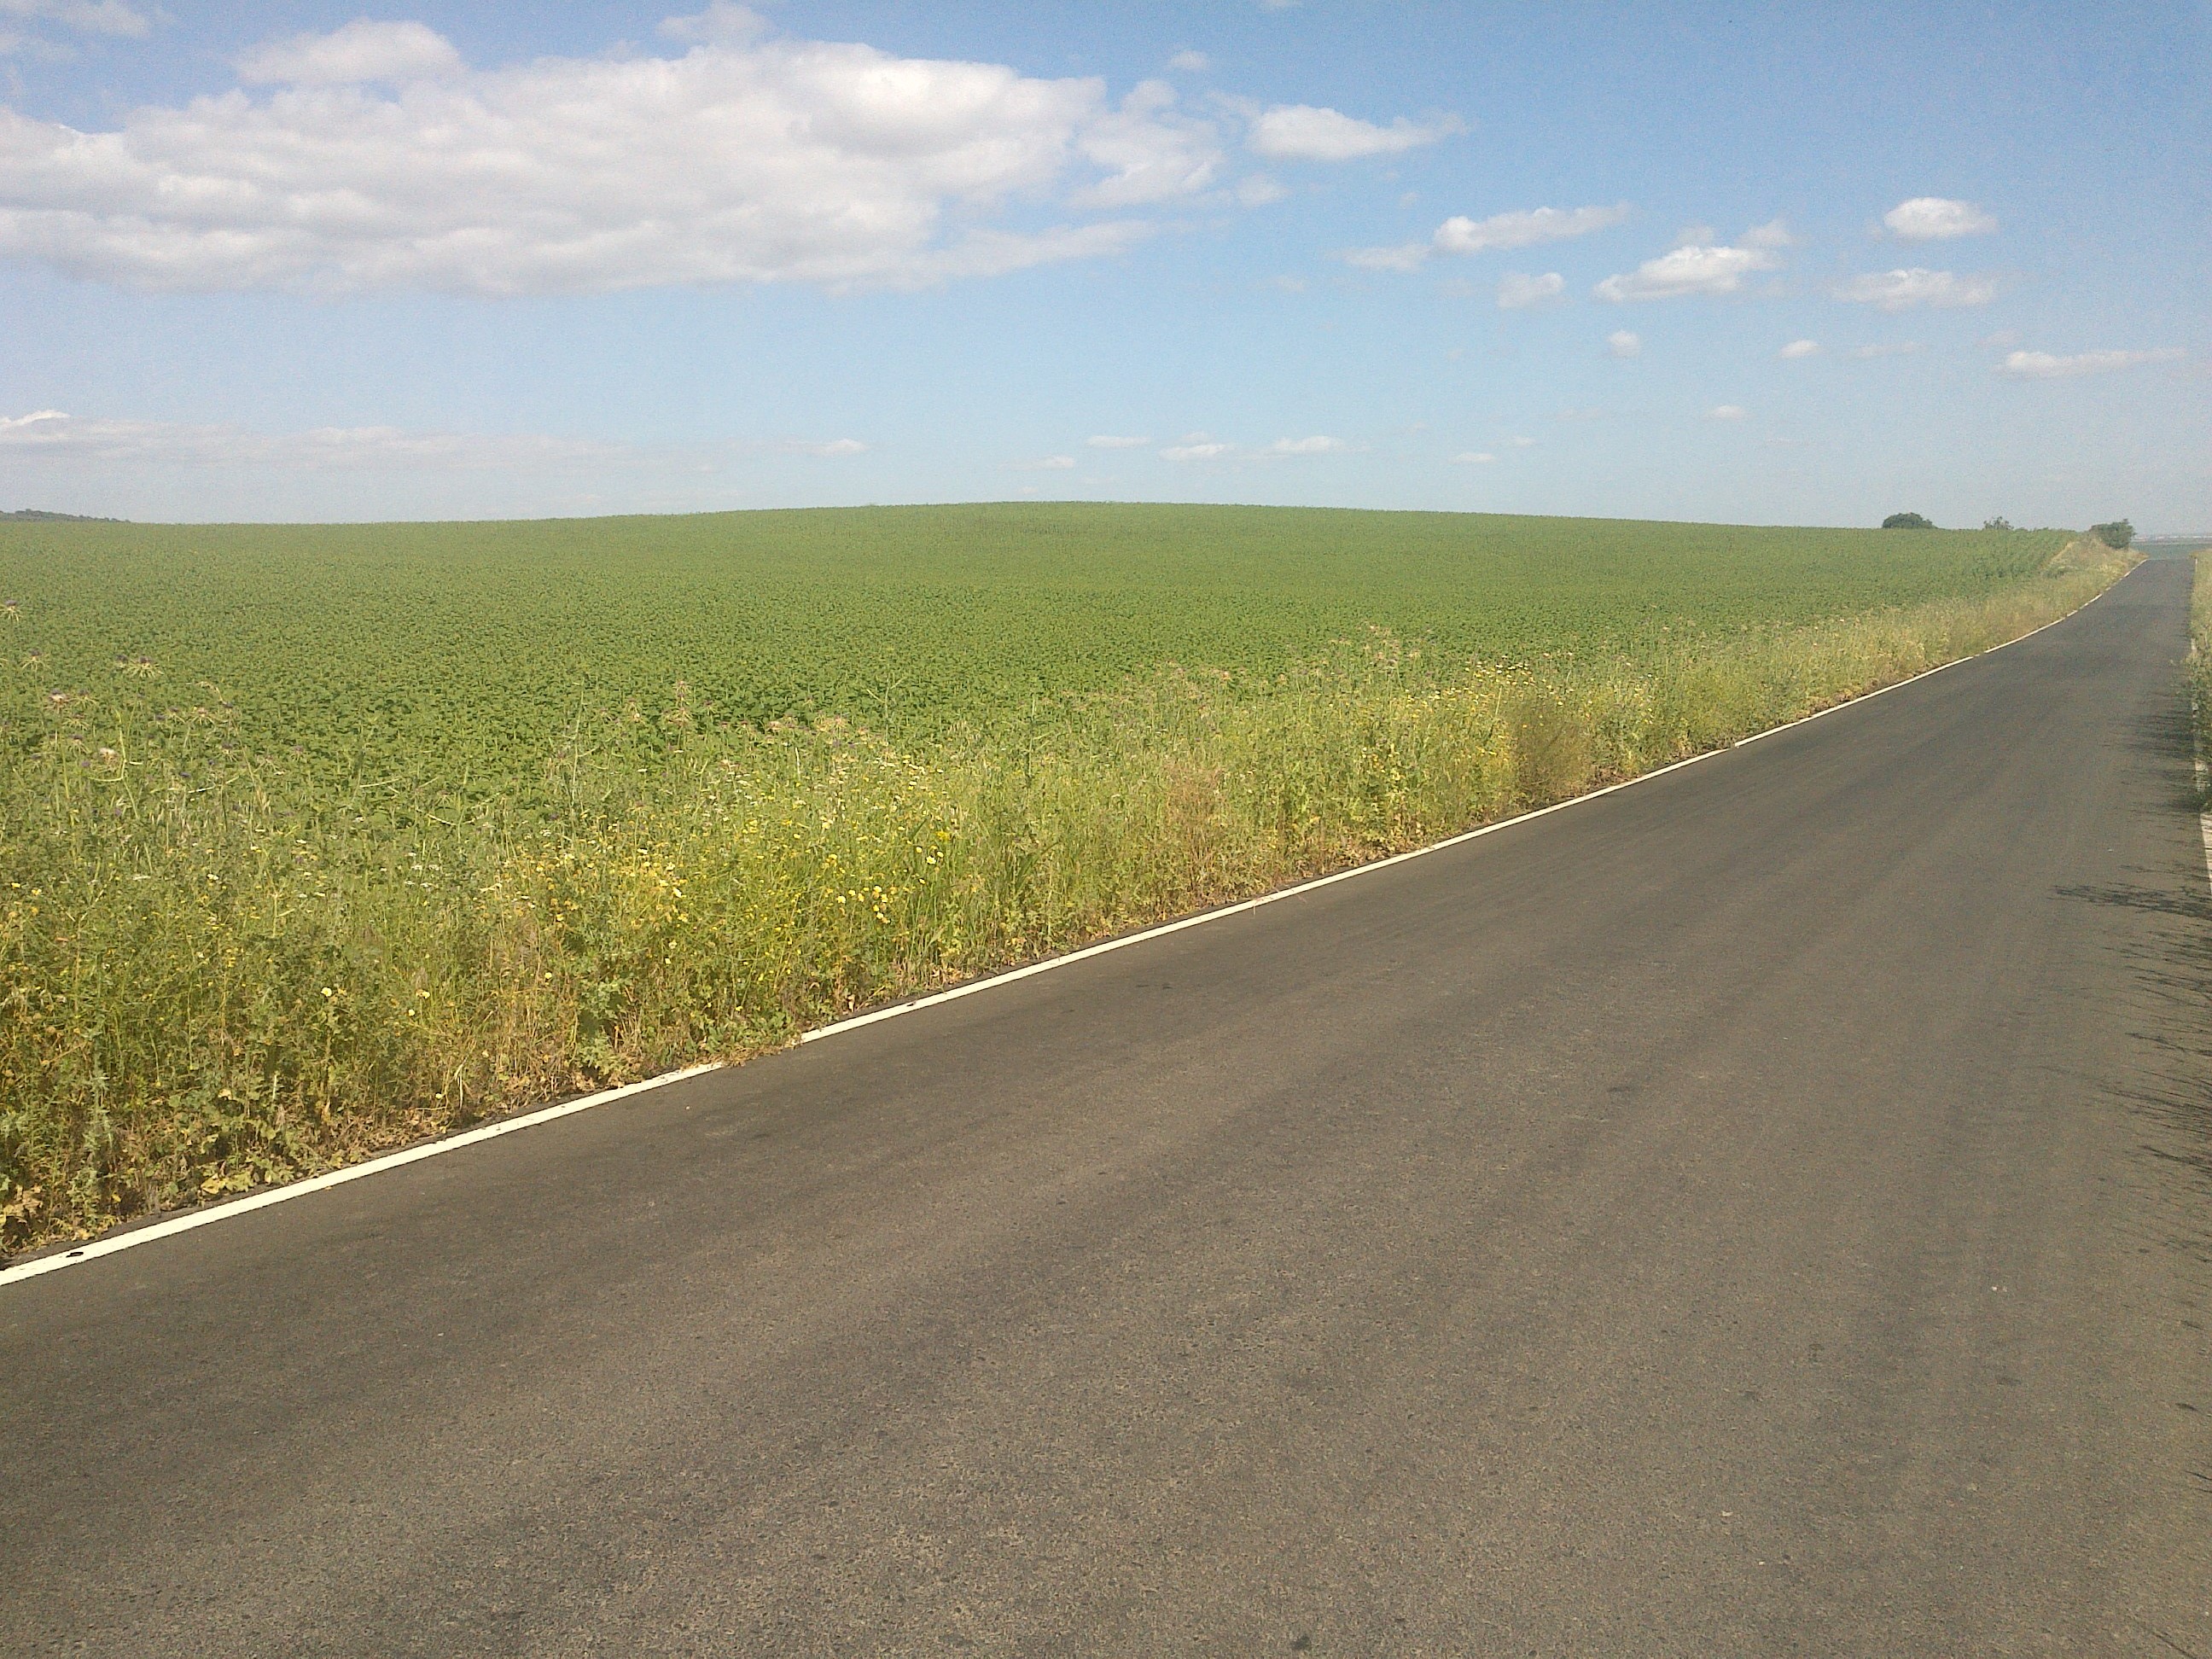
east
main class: Cropland
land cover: Sunflower
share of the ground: > 75 %
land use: Agriculture (excluding fallow land and kitchen gardens)
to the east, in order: Sunflower
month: May
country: ES
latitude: 37.8093
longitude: -5.1825
